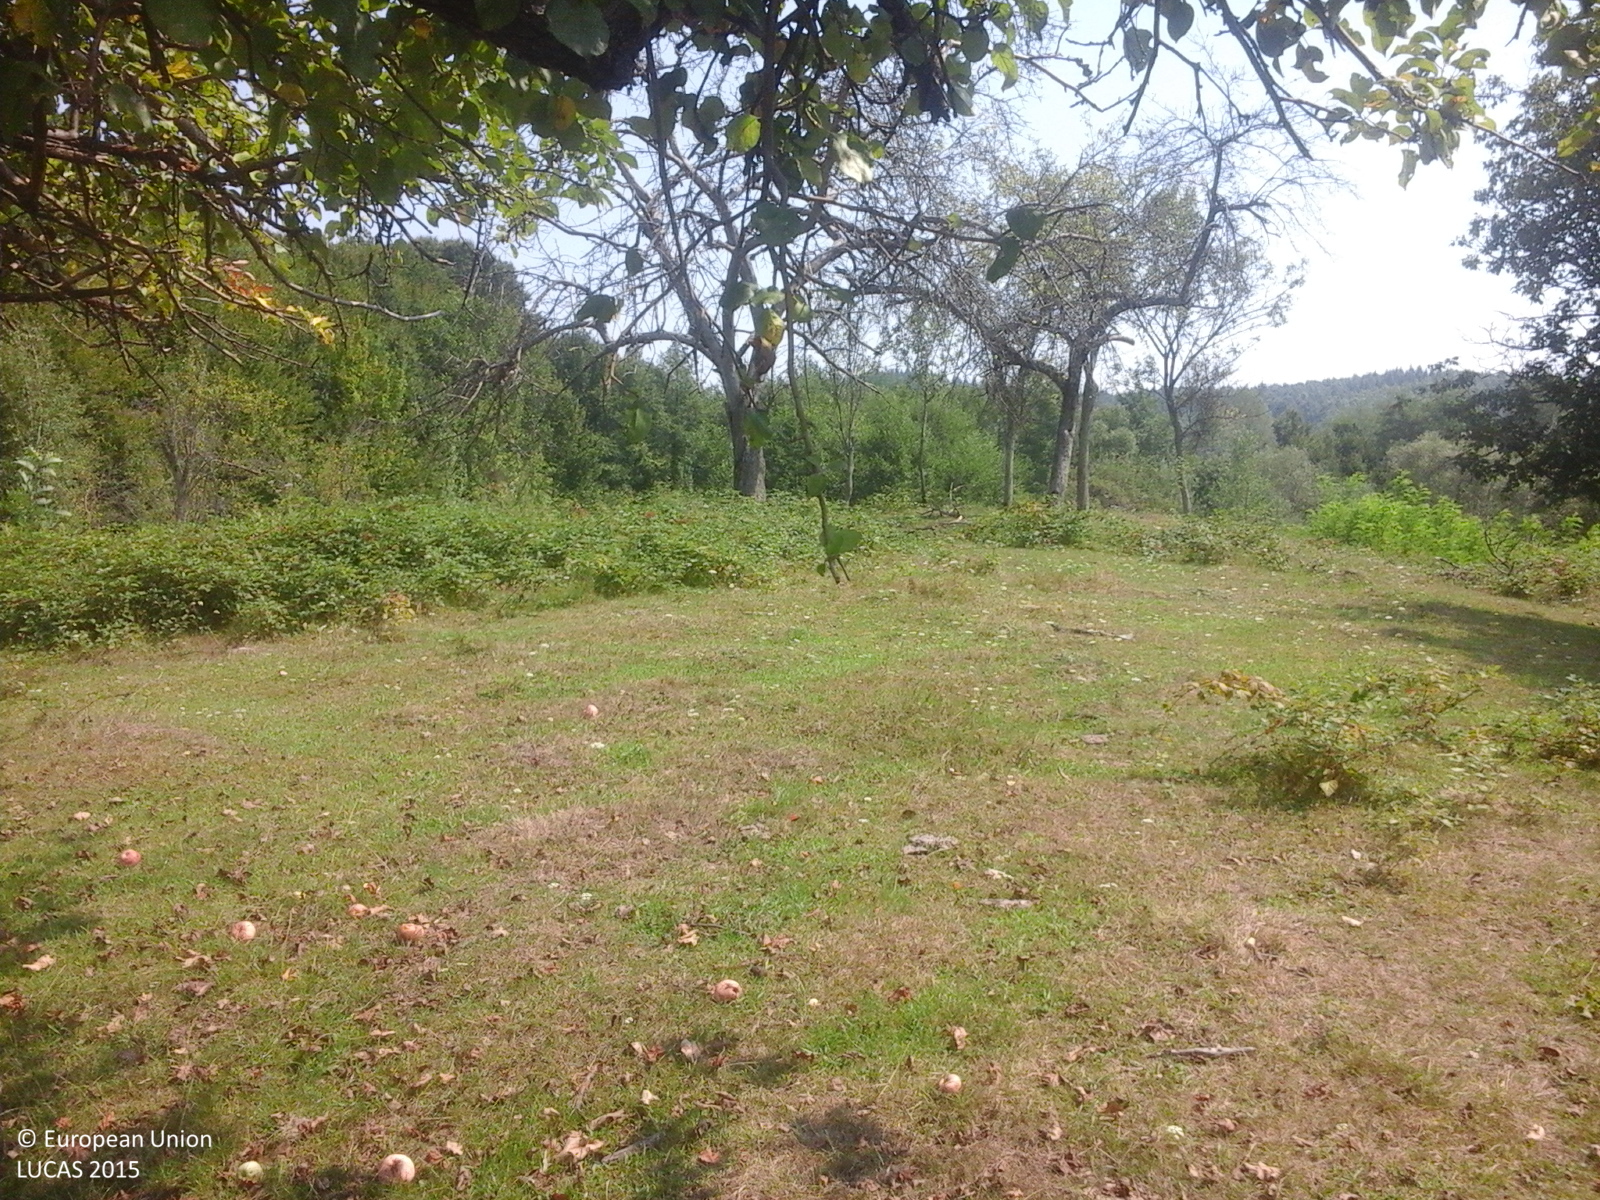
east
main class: Cropland
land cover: Apple fruit
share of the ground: > 75 %
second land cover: Grassland without tree/shrub cover
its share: > 75 %
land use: Agriculture (excluding fallow land and kitchen gardens)
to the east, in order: Apple fruit; Grassland without tree/shrub cover; Broadleaved woodland
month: August
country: RO
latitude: 46.3182
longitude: 22.5578
